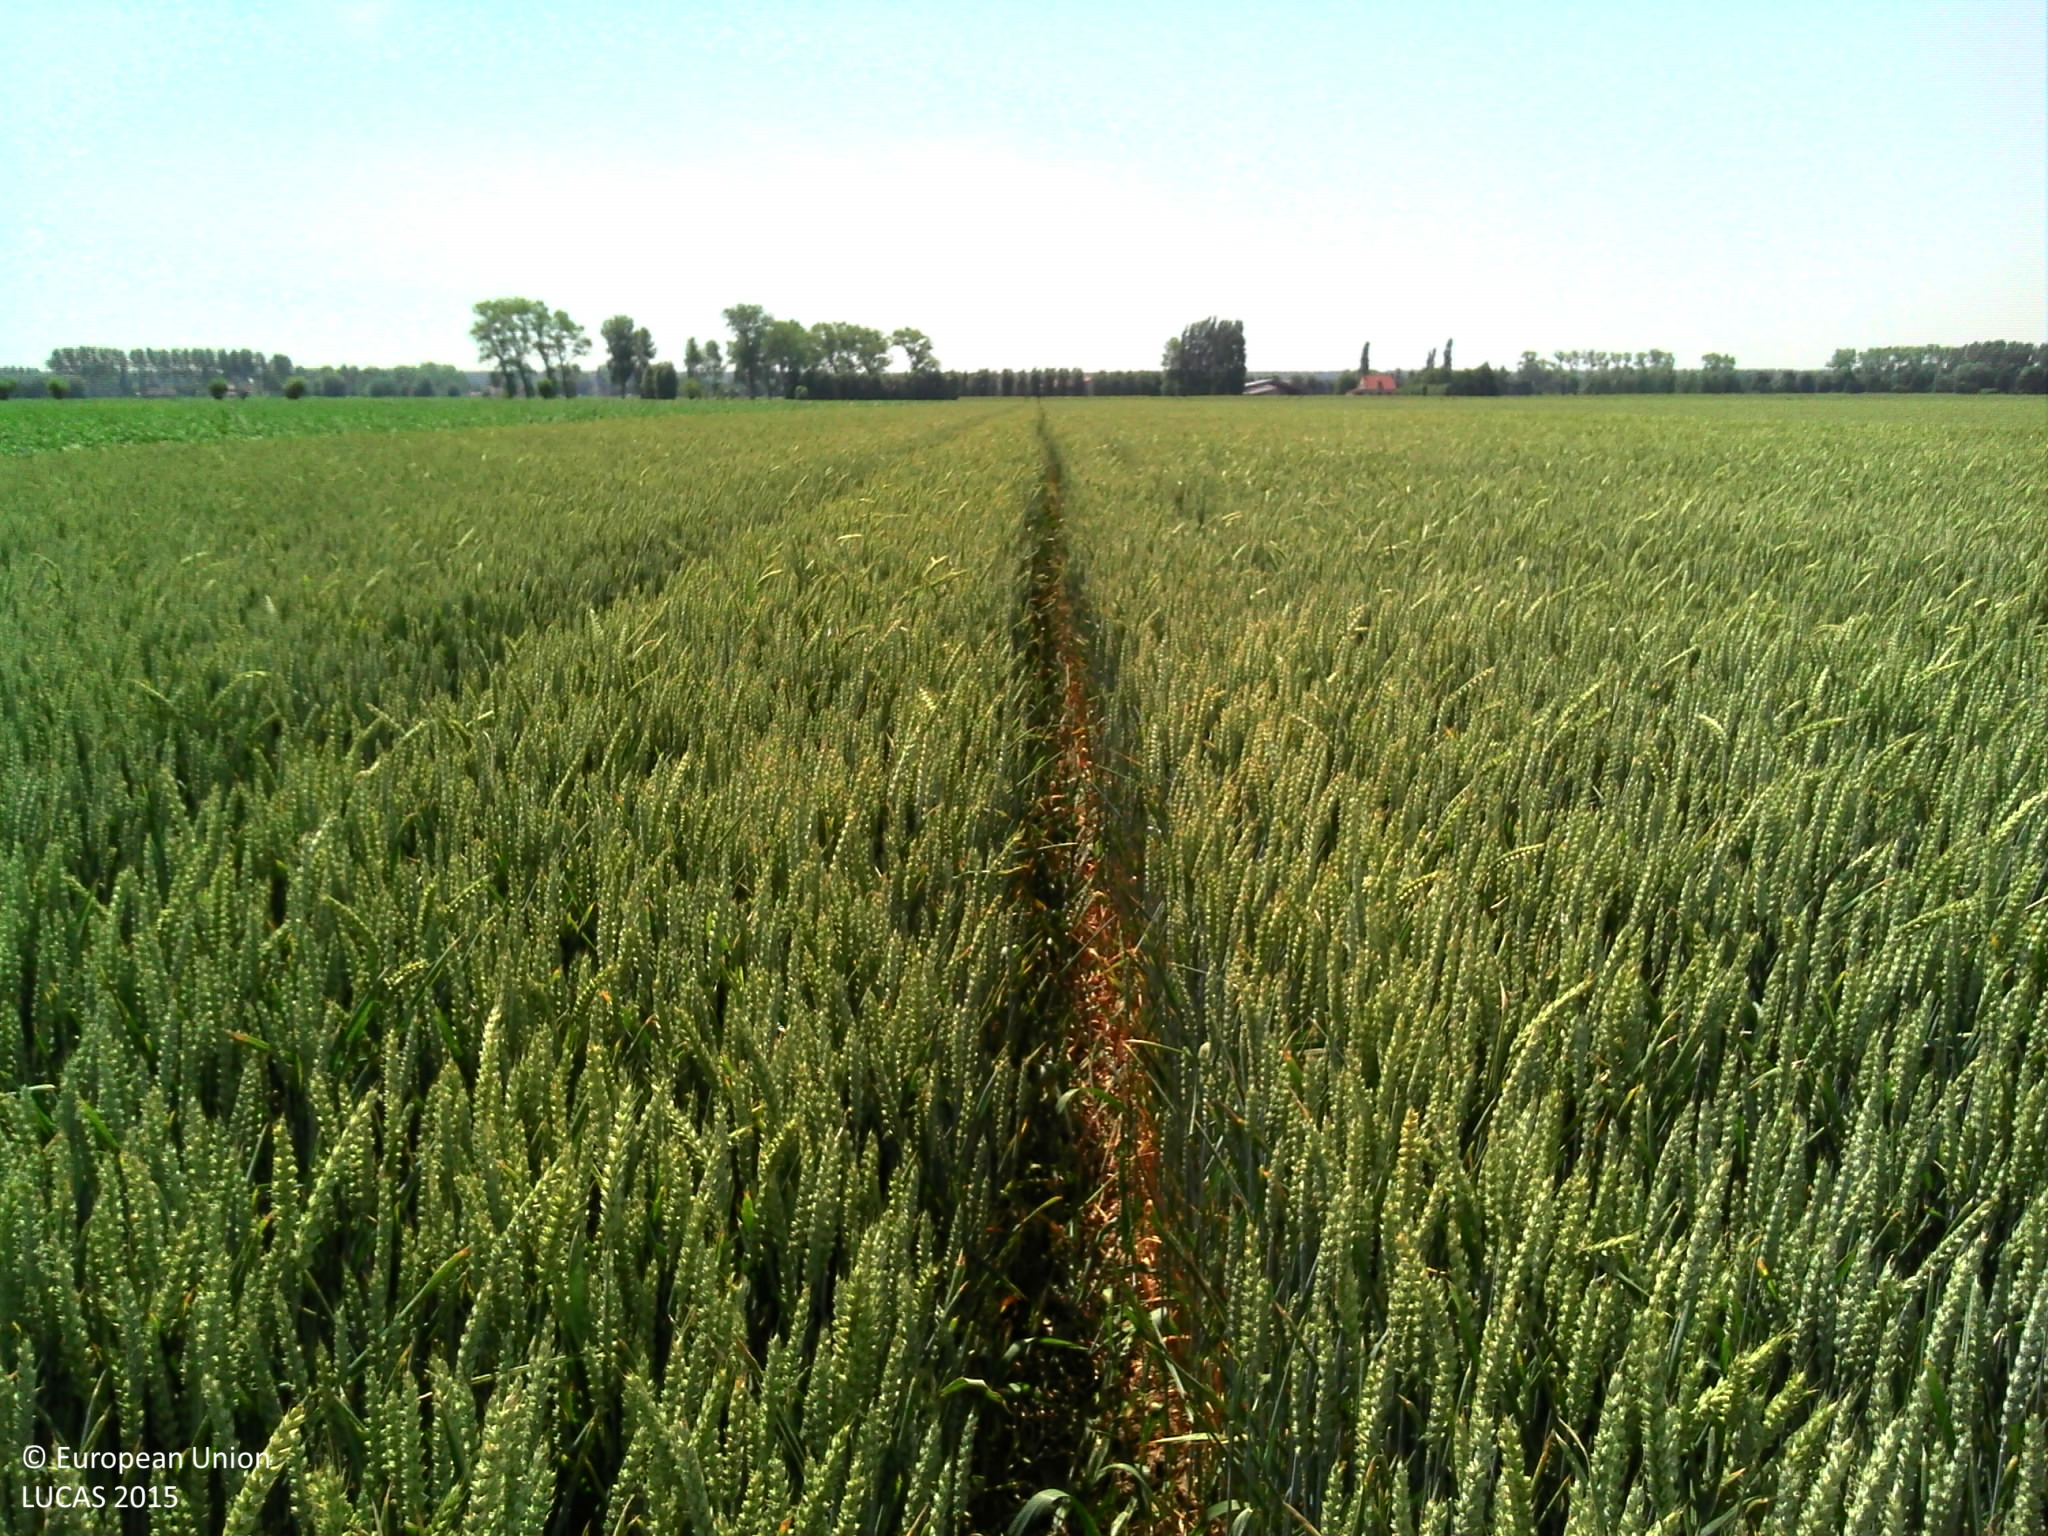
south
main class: Cropland
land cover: Common wheat
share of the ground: > 75 %
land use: Agriculture (excluding fallow land and kitchen gardens)
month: July
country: BE
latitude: 51.2729
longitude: 3.3836
